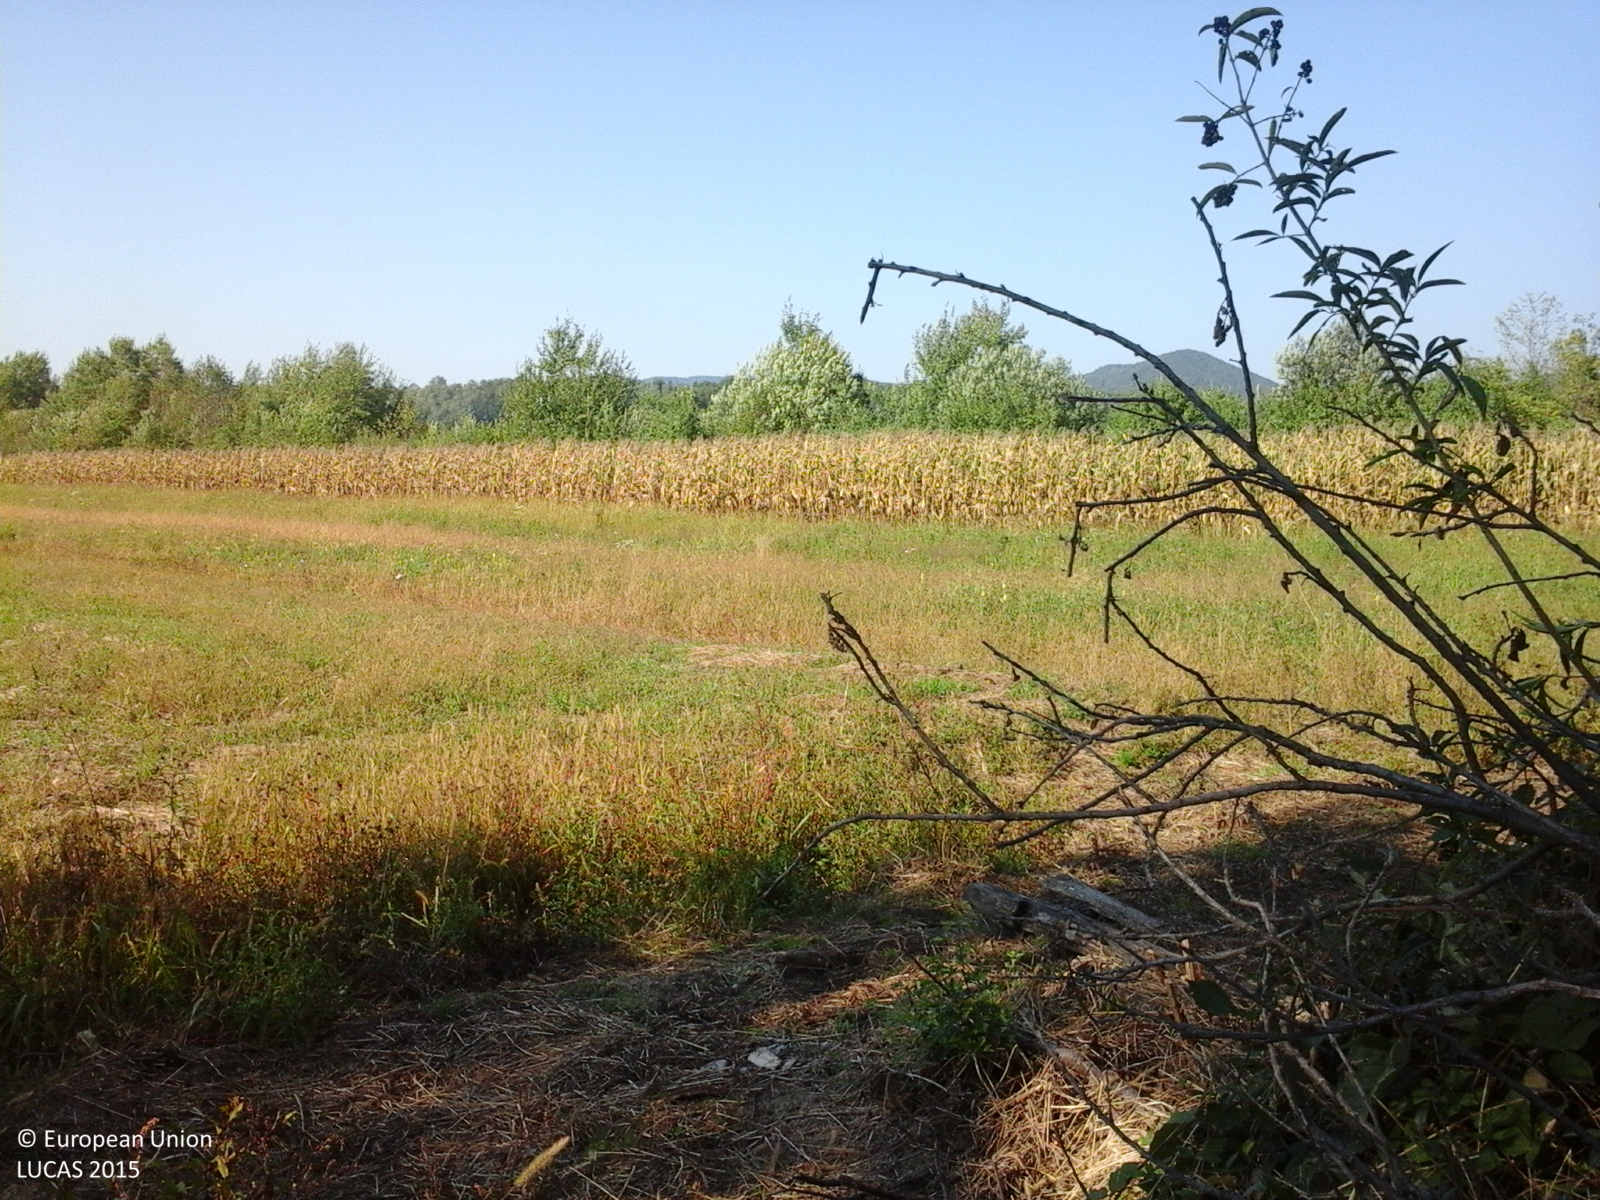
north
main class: Grassland
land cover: Grassland without tree/shrub cover
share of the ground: > 75 %
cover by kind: herbaceous plants 100 %
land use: Agriculture (excluding fallow land and kitchen gardens)
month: September
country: RO
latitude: 46.7115
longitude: 22.4660
